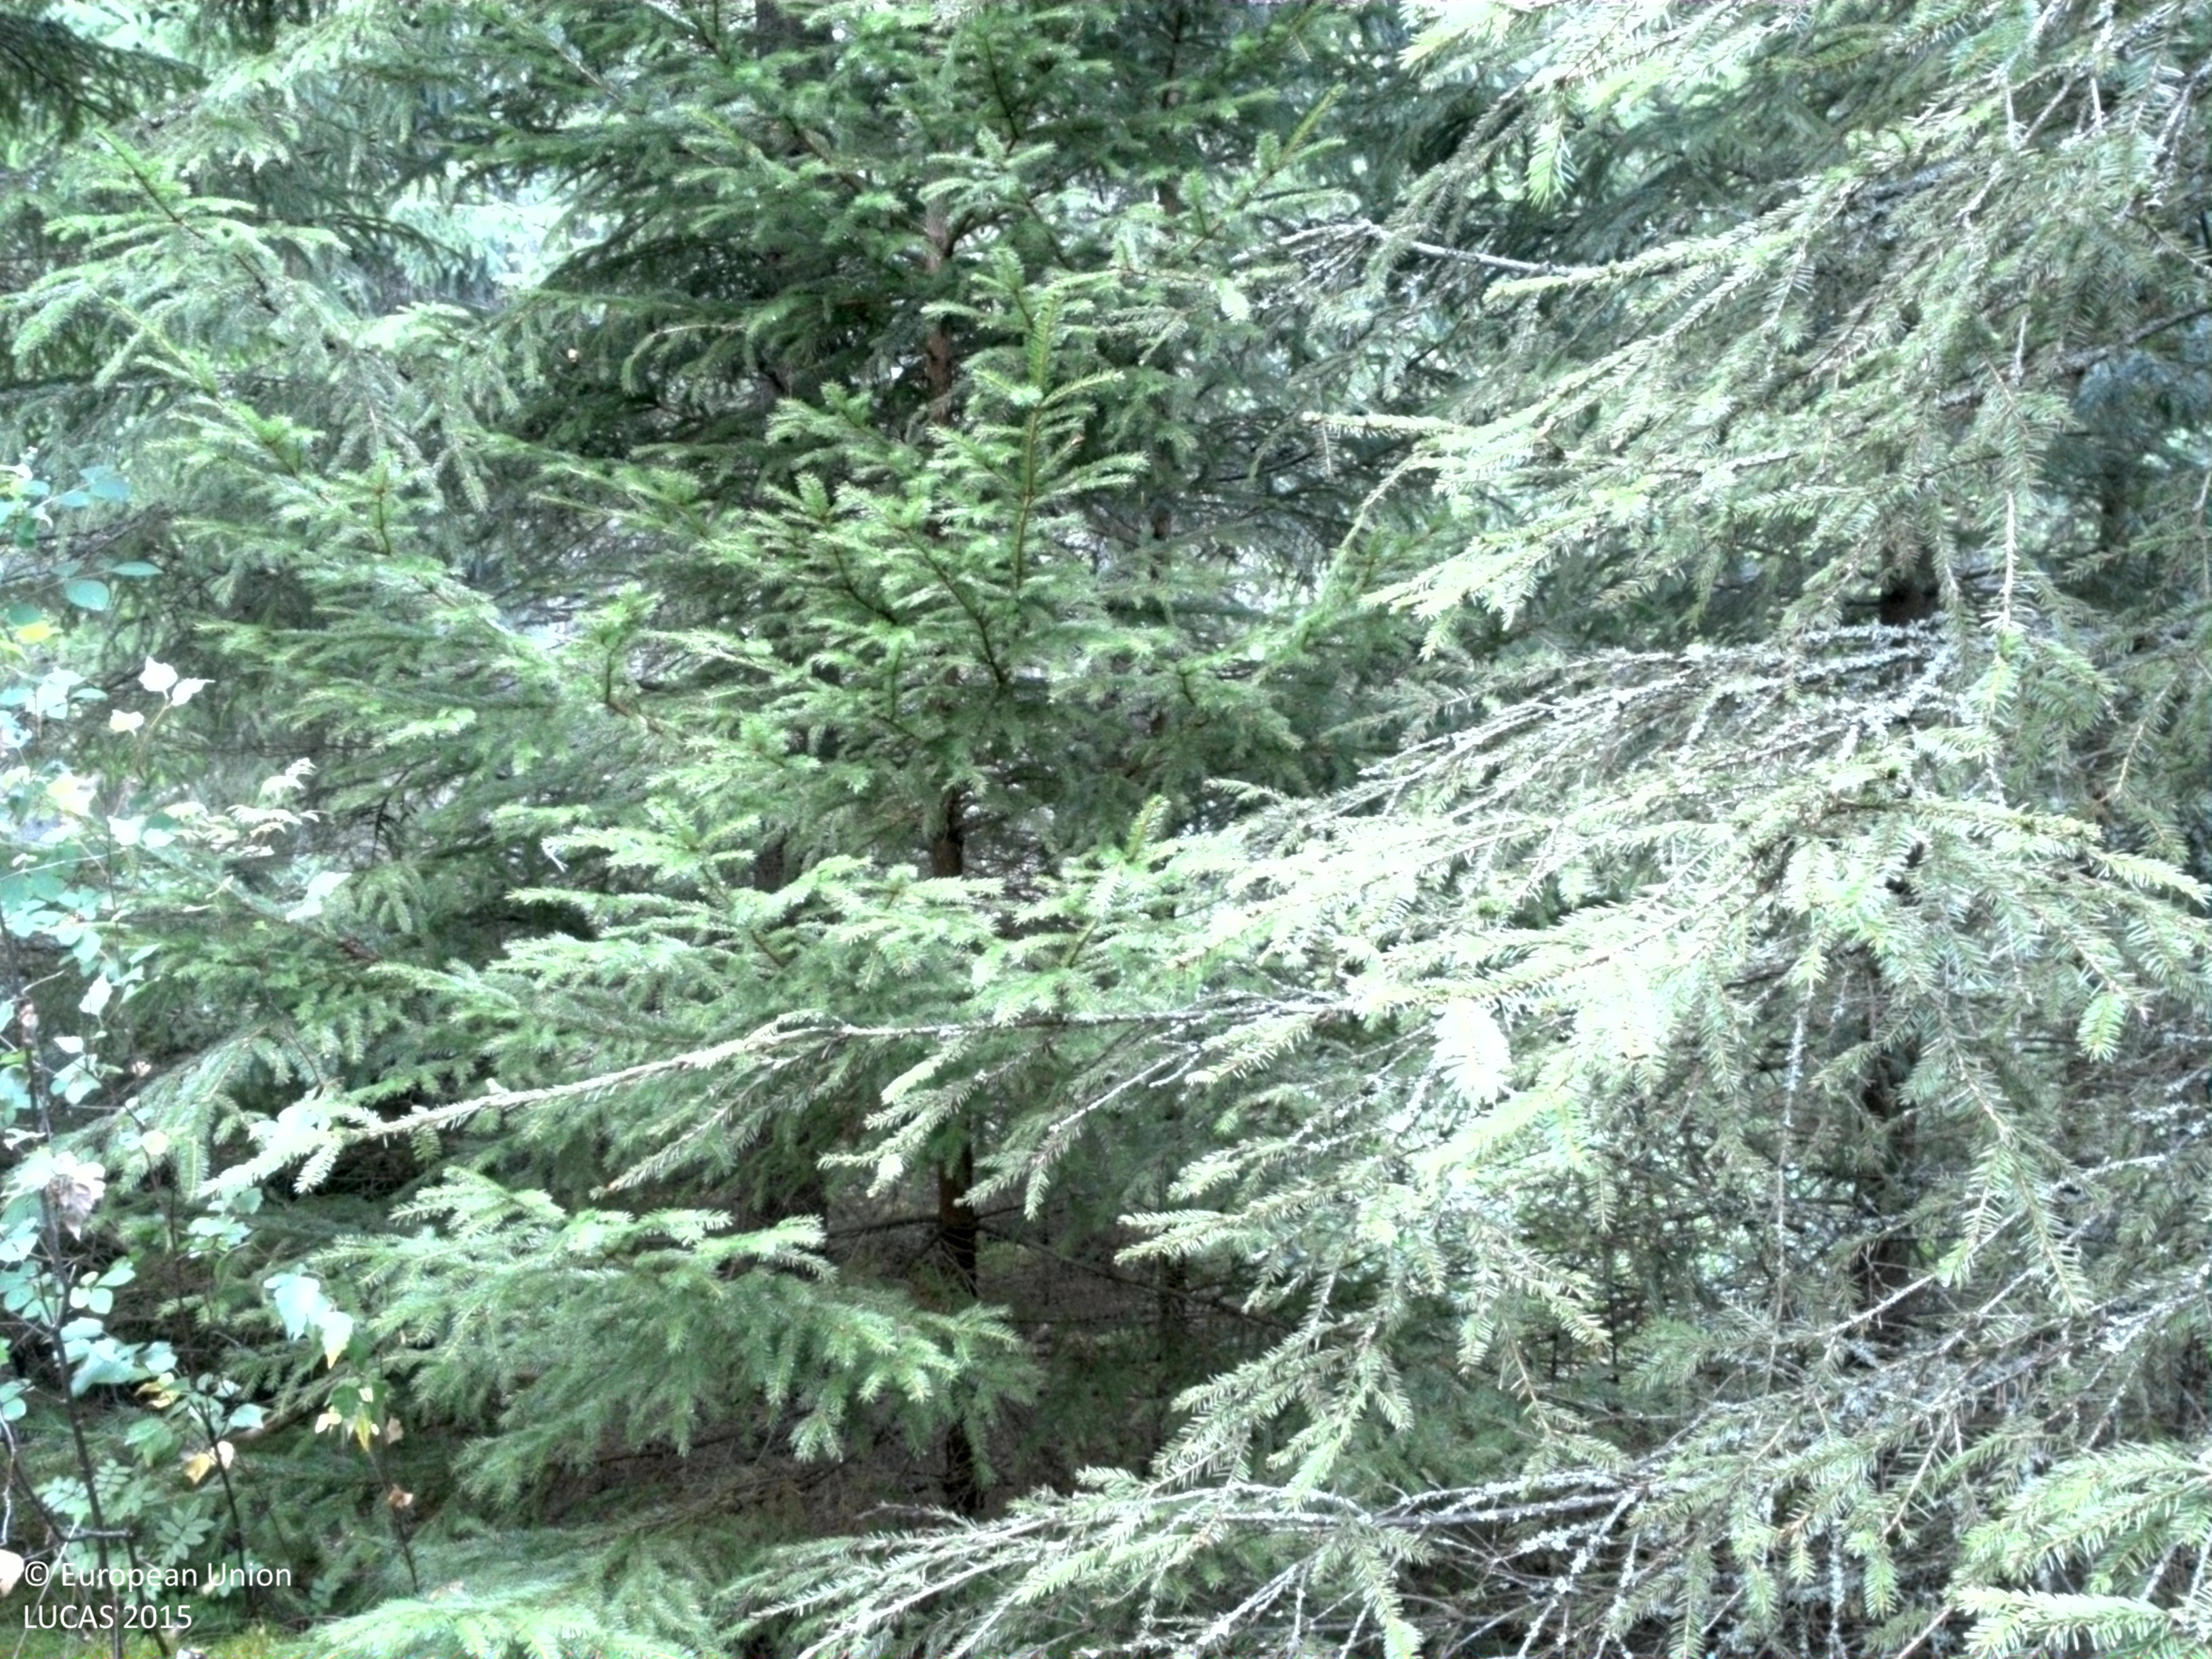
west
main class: Woodland
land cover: Spruce dominated coniferous woodland
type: boreal forest
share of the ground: > 75 %
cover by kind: coniferous forest trees 75 %, lichens and mosses 20 %, broadleaved forest trees 5 %
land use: Forestry
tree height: > 5 m
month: August
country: SE
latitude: 59.9892
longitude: 17.6835
